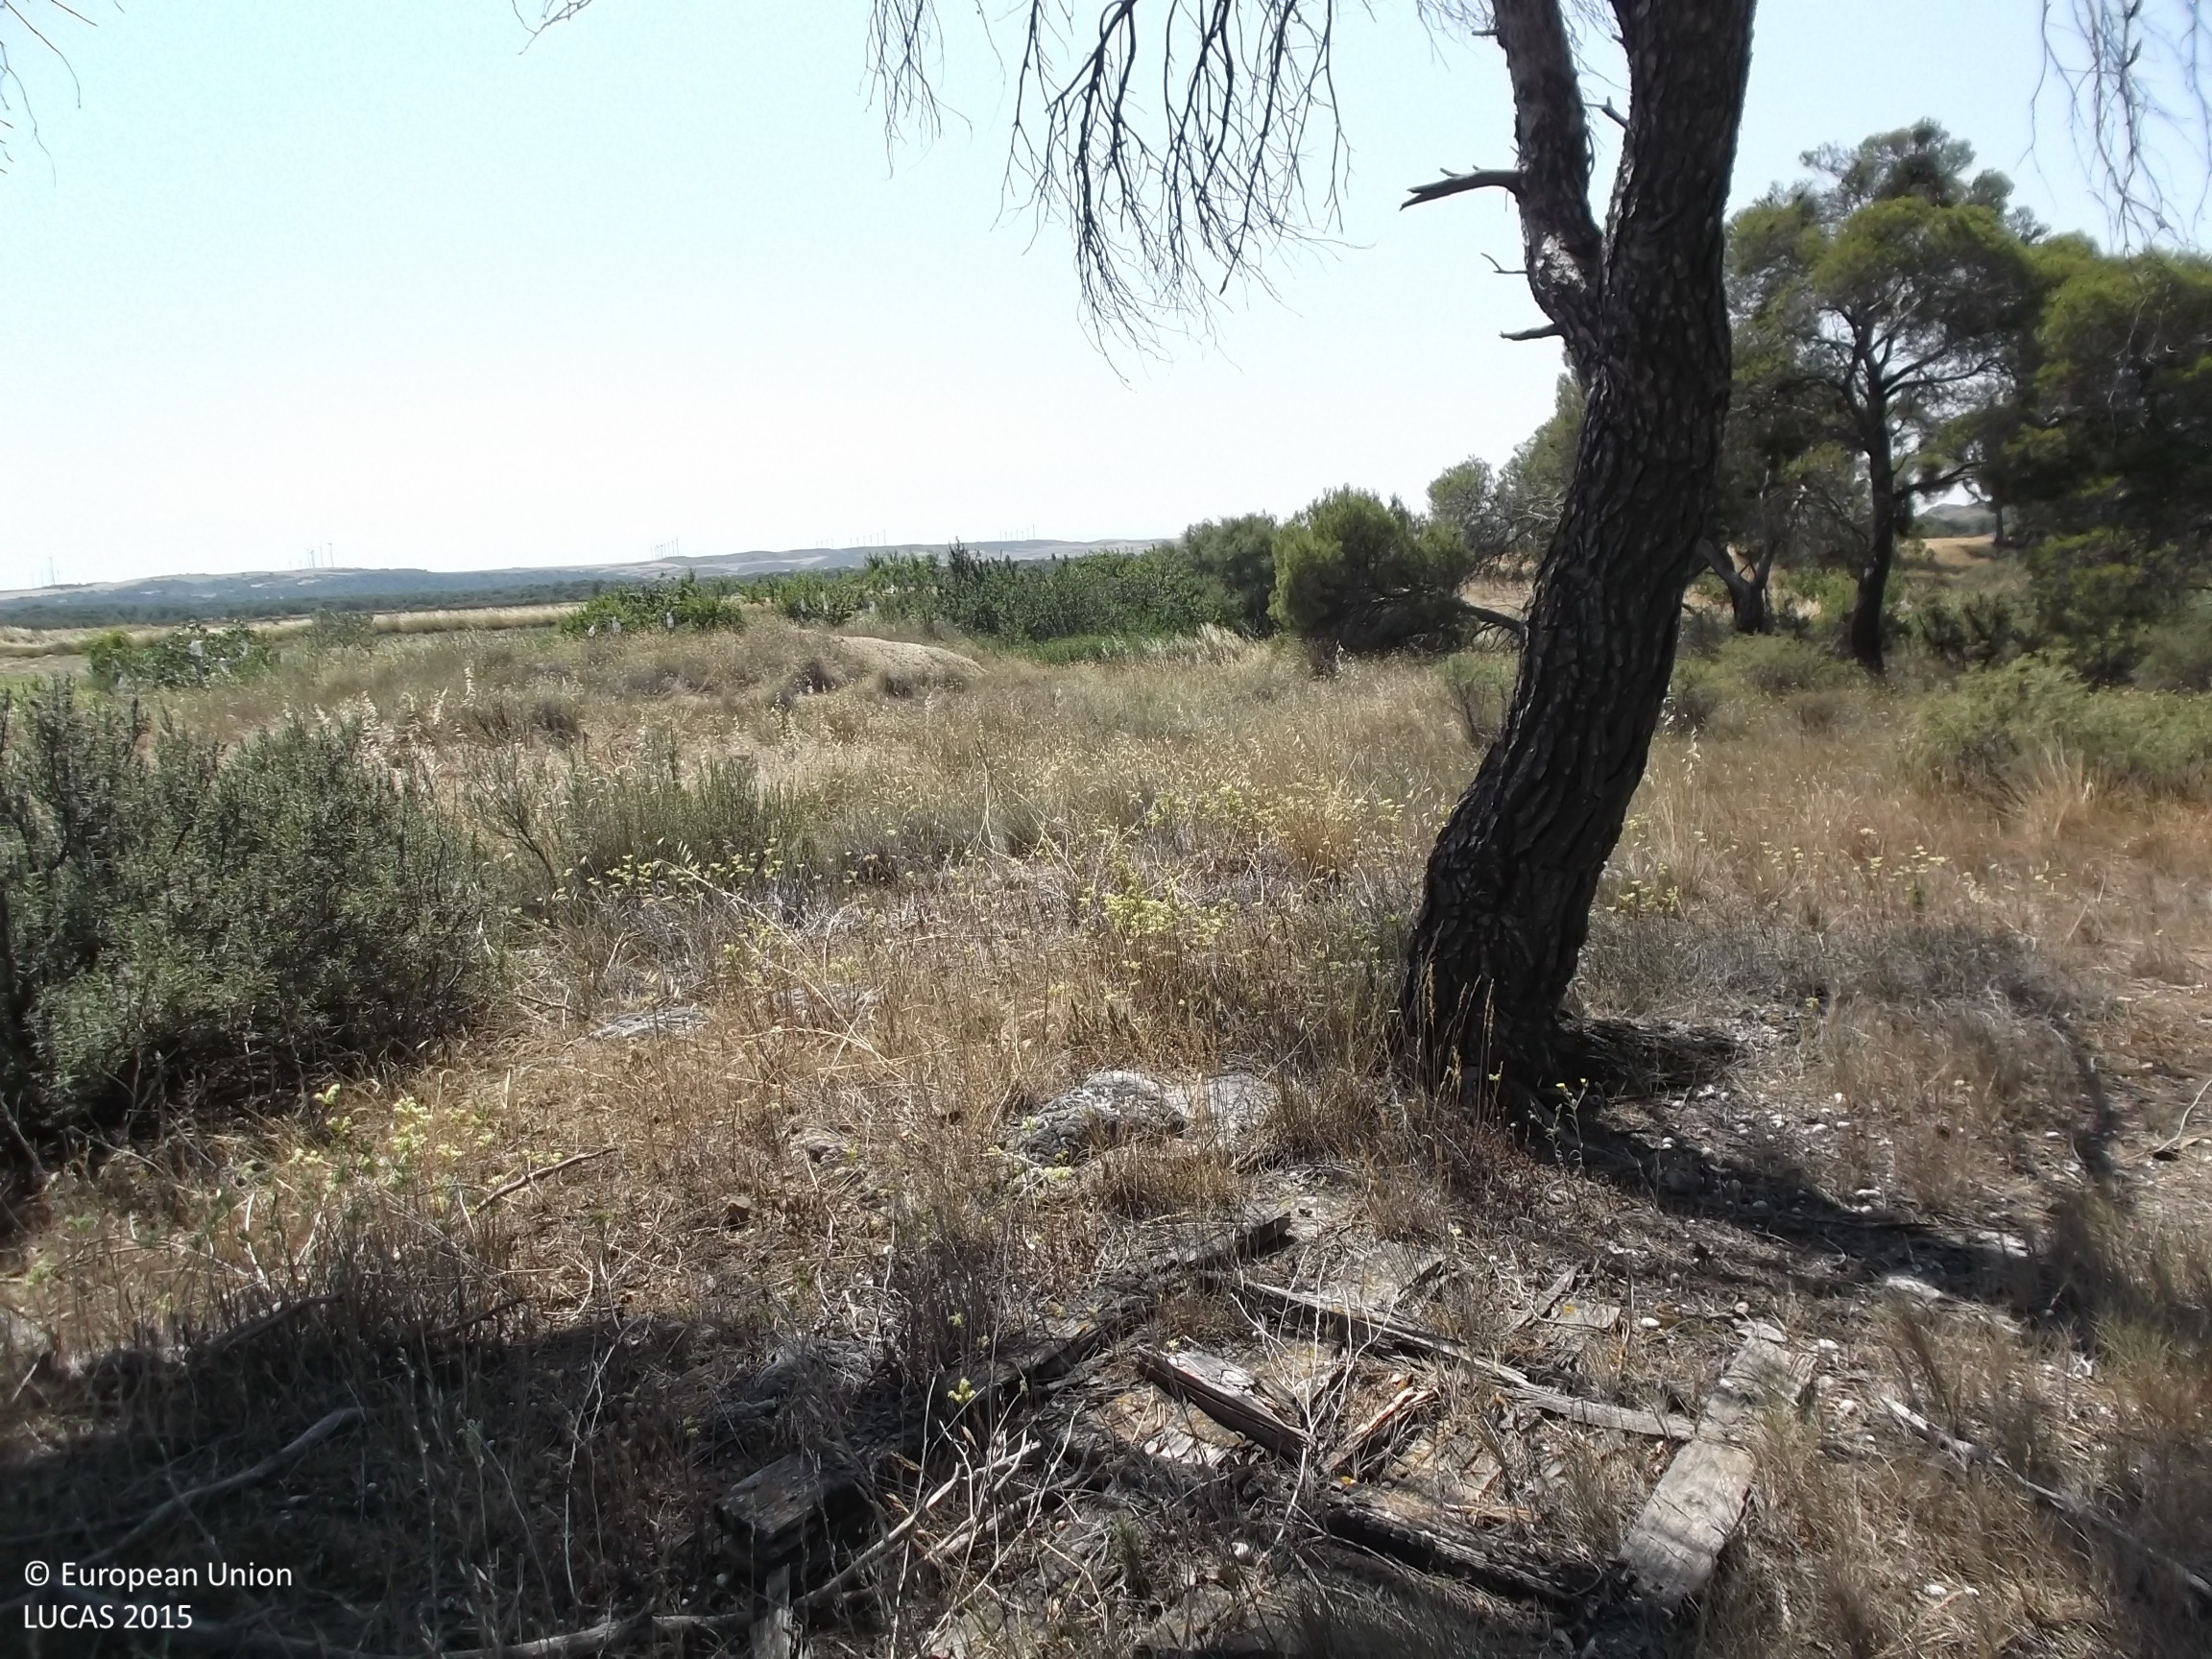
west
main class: Woodland
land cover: Pine dominated coniferous woodland
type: coniferous forest of the mediterranean region
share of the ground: 25 - 50 %
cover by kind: coniferous forest trees 40 %, herbaceous plants 30 %, unconsolidated bare surface 25 %
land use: Semi-natural and natural areas not in use
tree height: > 5 m
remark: Burnt area
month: July
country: ES
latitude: 42.3164
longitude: -1.5725
